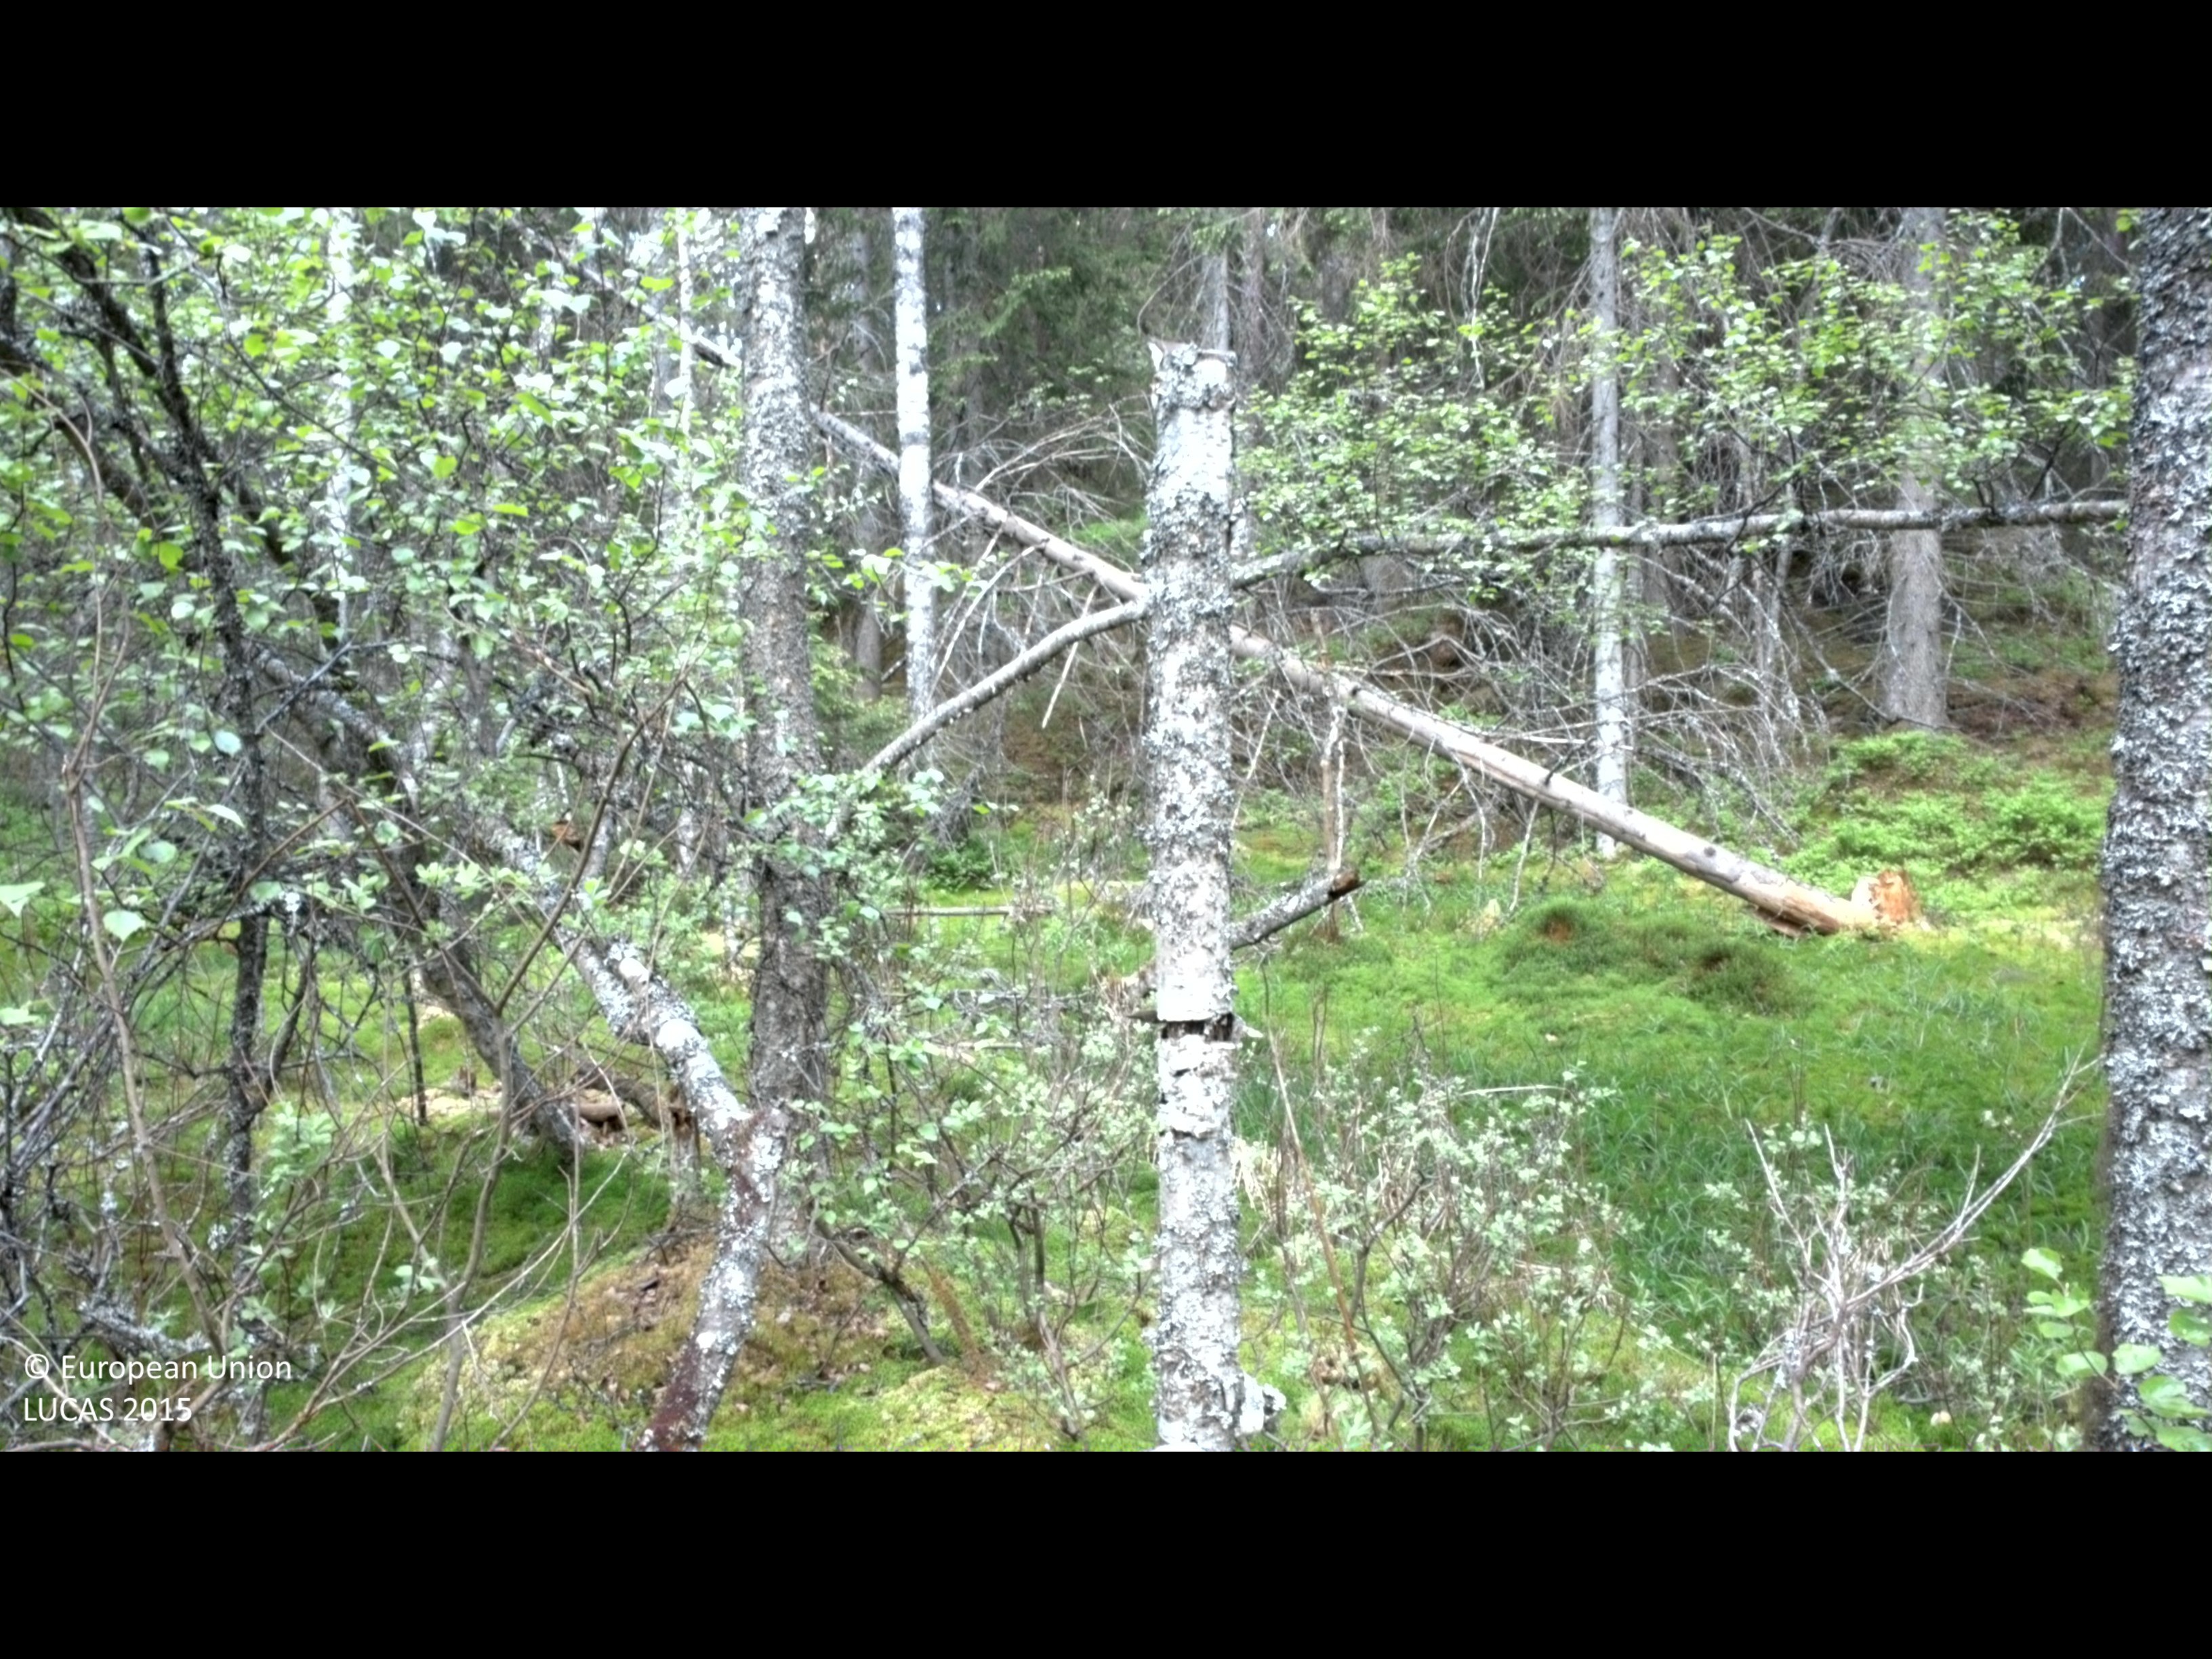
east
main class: Woodland
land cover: Pine dominated mixed woodland
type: boreal forest
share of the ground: > 75 %
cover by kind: coniferous forest trees 60 %, broadleaved forest trees 20 %, shrubs 10 %, lichens and mosses 10 %
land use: Forestry
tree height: > 5 m
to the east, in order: Pine dominated mixed woodland; Spruce dominated coniferous woodland; Pine dominated coniferous woodland
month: May
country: SE
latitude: 57.3548
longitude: 16.1984
